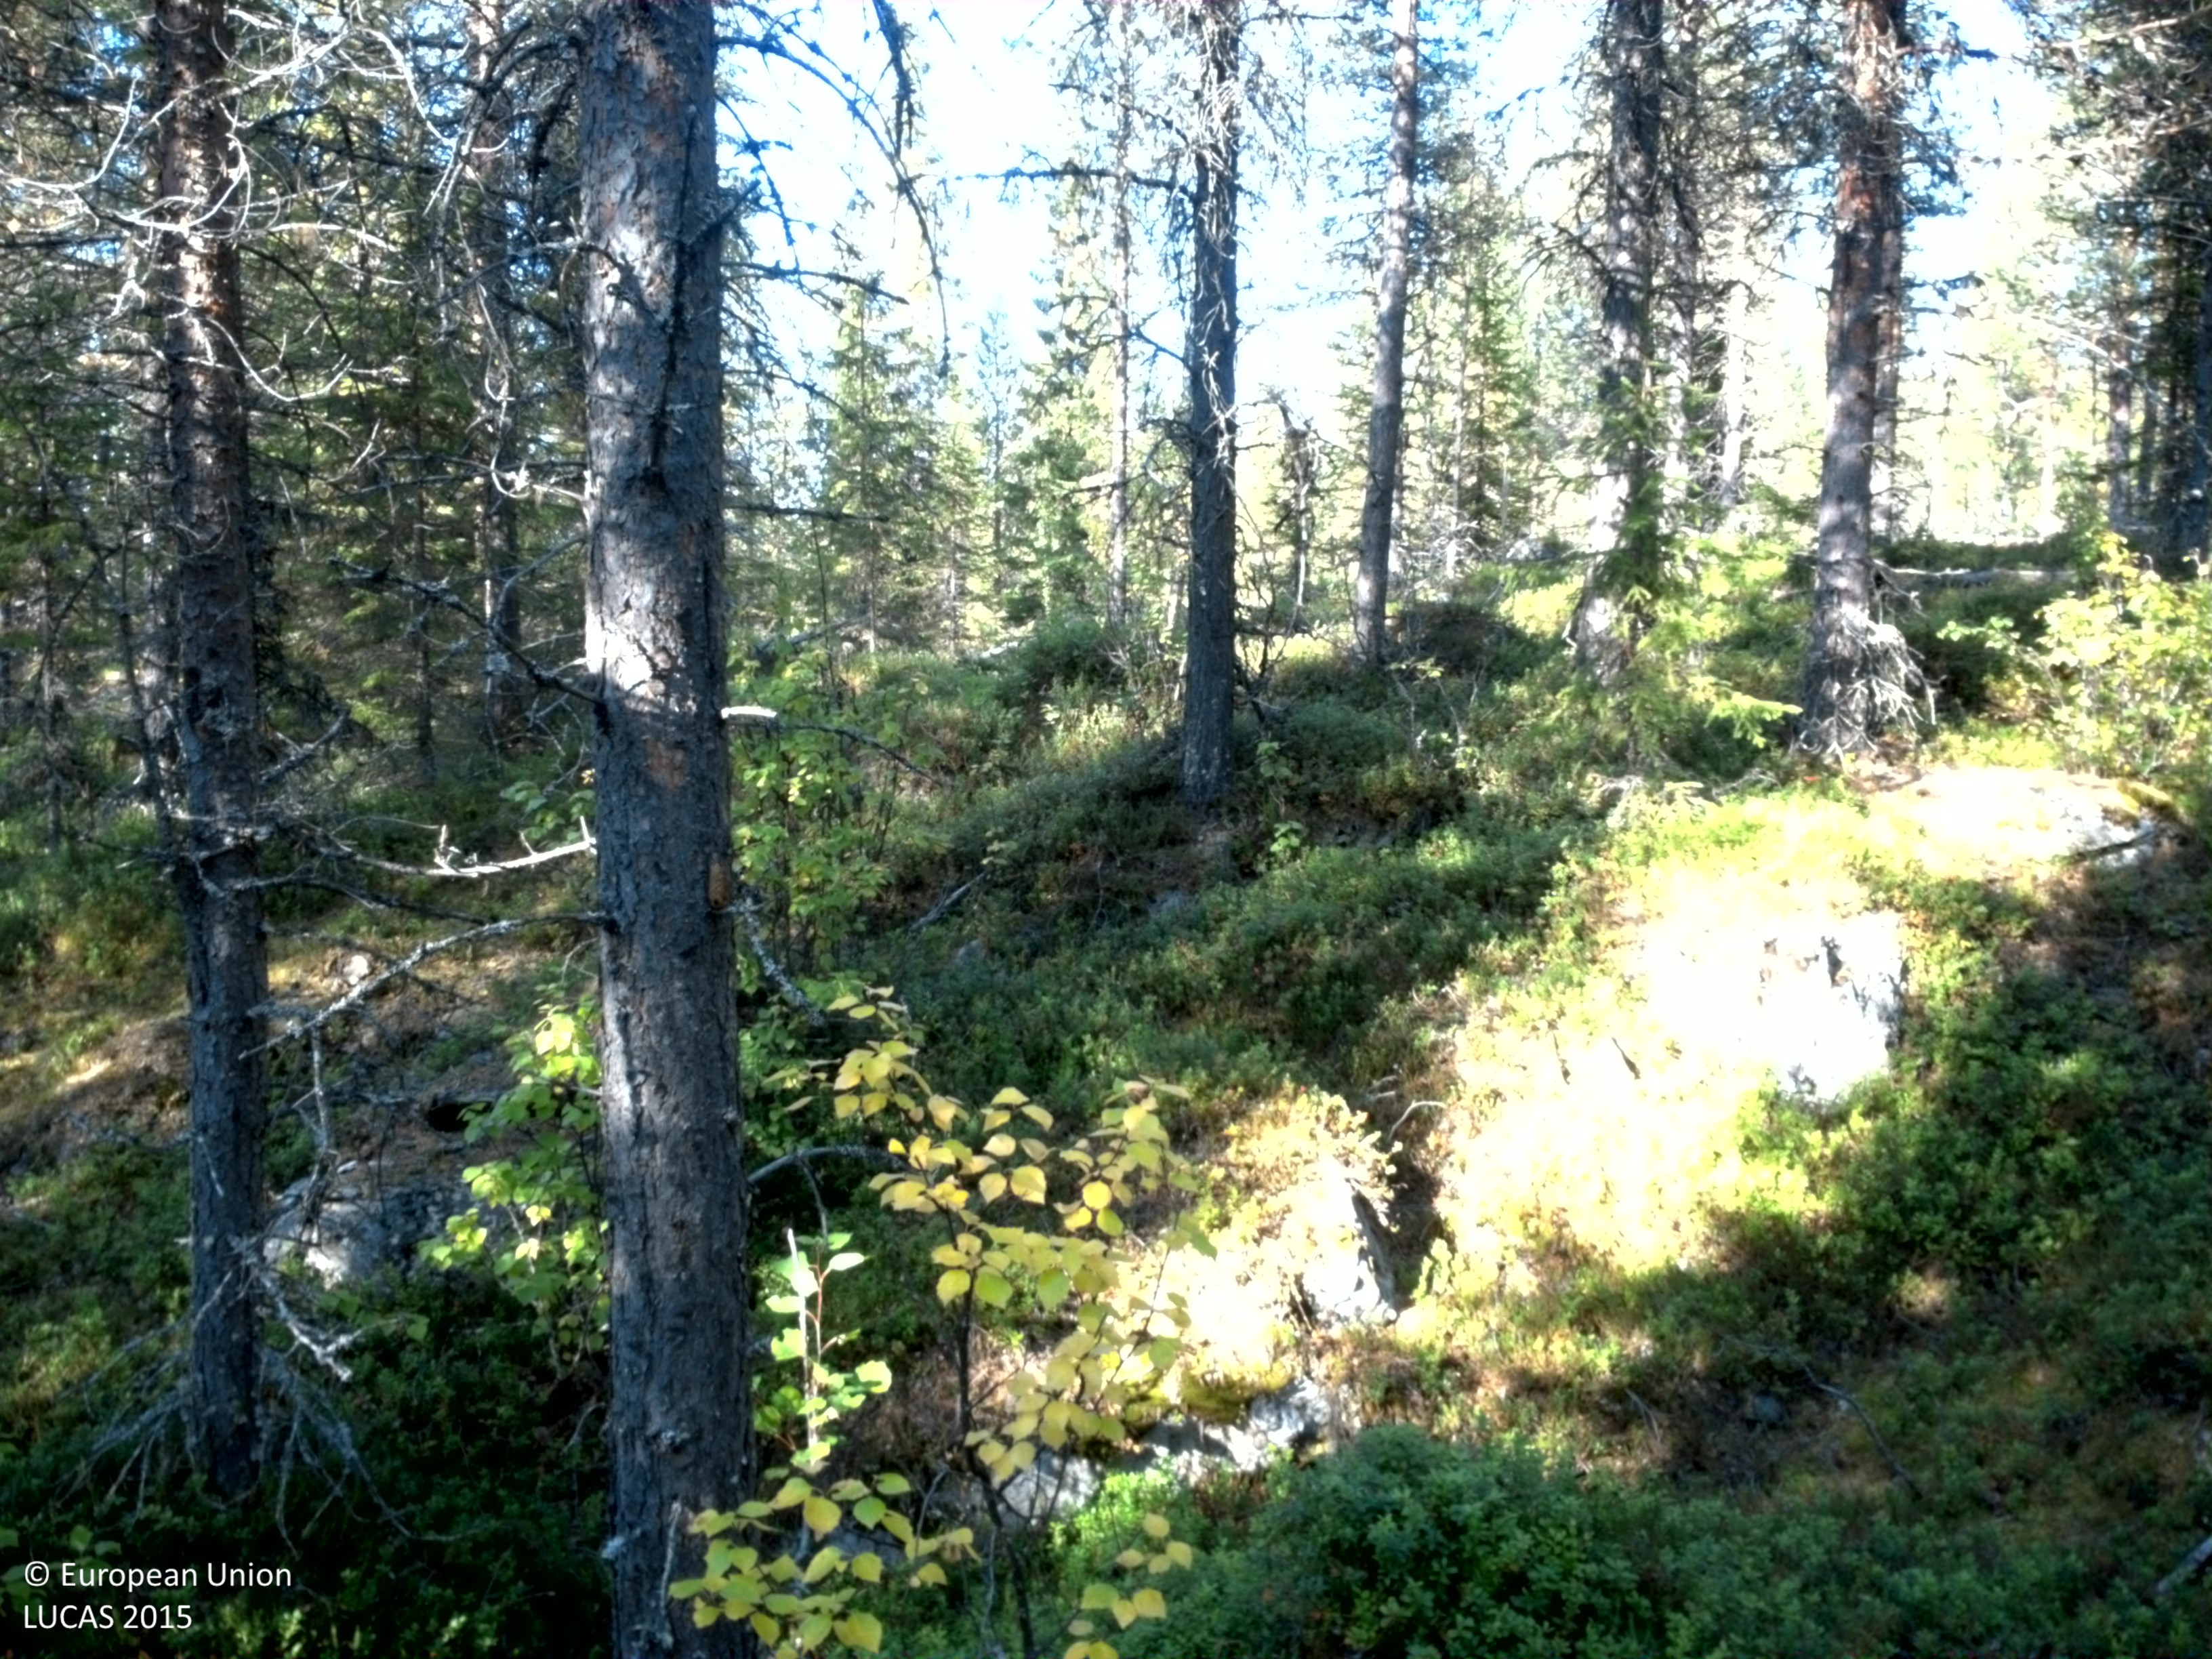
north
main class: Woodland
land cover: Pine dominated coniferous woodland
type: boreal forest
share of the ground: 25 - 50 %
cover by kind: shrubs 45 %, coniferous forest trees 40 %, lichens and mosses 10 %, broadleaved forest trees 5 %
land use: Forestry
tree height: > 5 m
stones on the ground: < 10 %
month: September
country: SE
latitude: 65.3949
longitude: 16.3554
